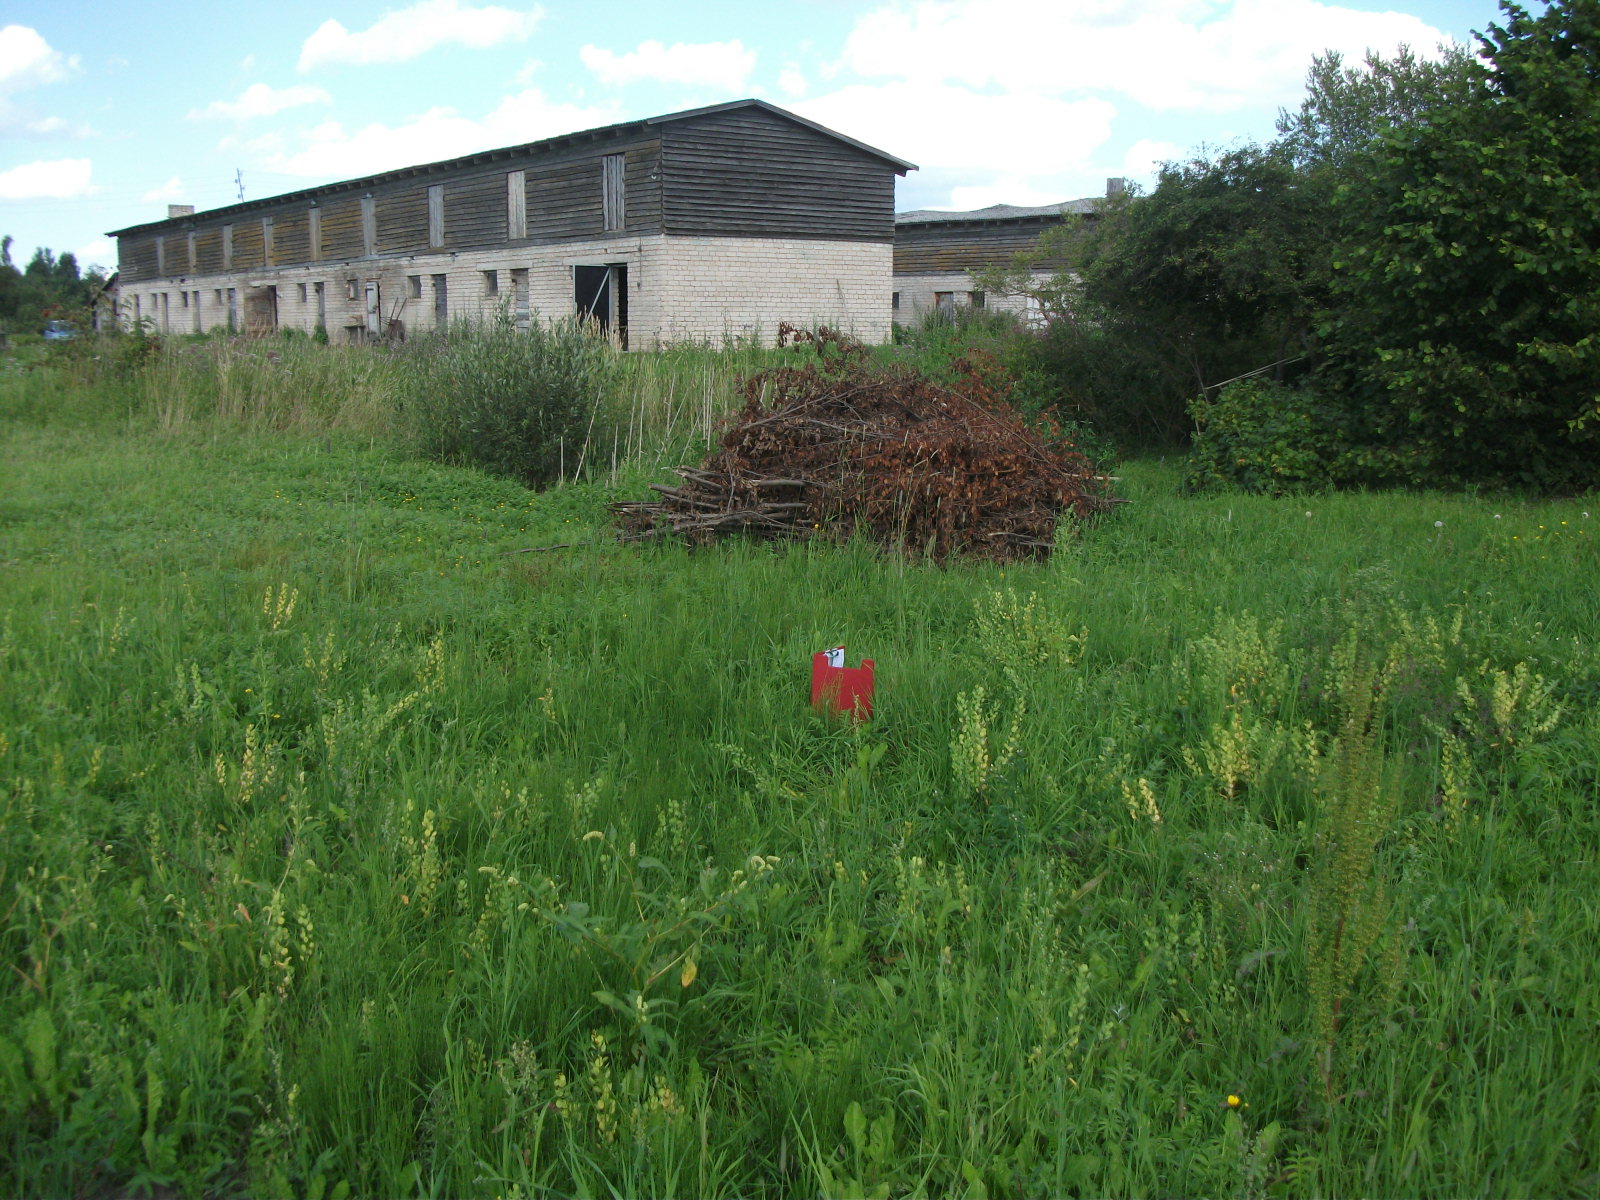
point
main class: Grassland
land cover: Grassland without tree/shrub cover
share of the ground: > 75 %
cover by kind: herbaceous plants 100 %
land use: Agriculture (excluding fallow land and kitchen gardens)
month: August
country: LV
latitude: 57.0797
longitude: 26.6303
